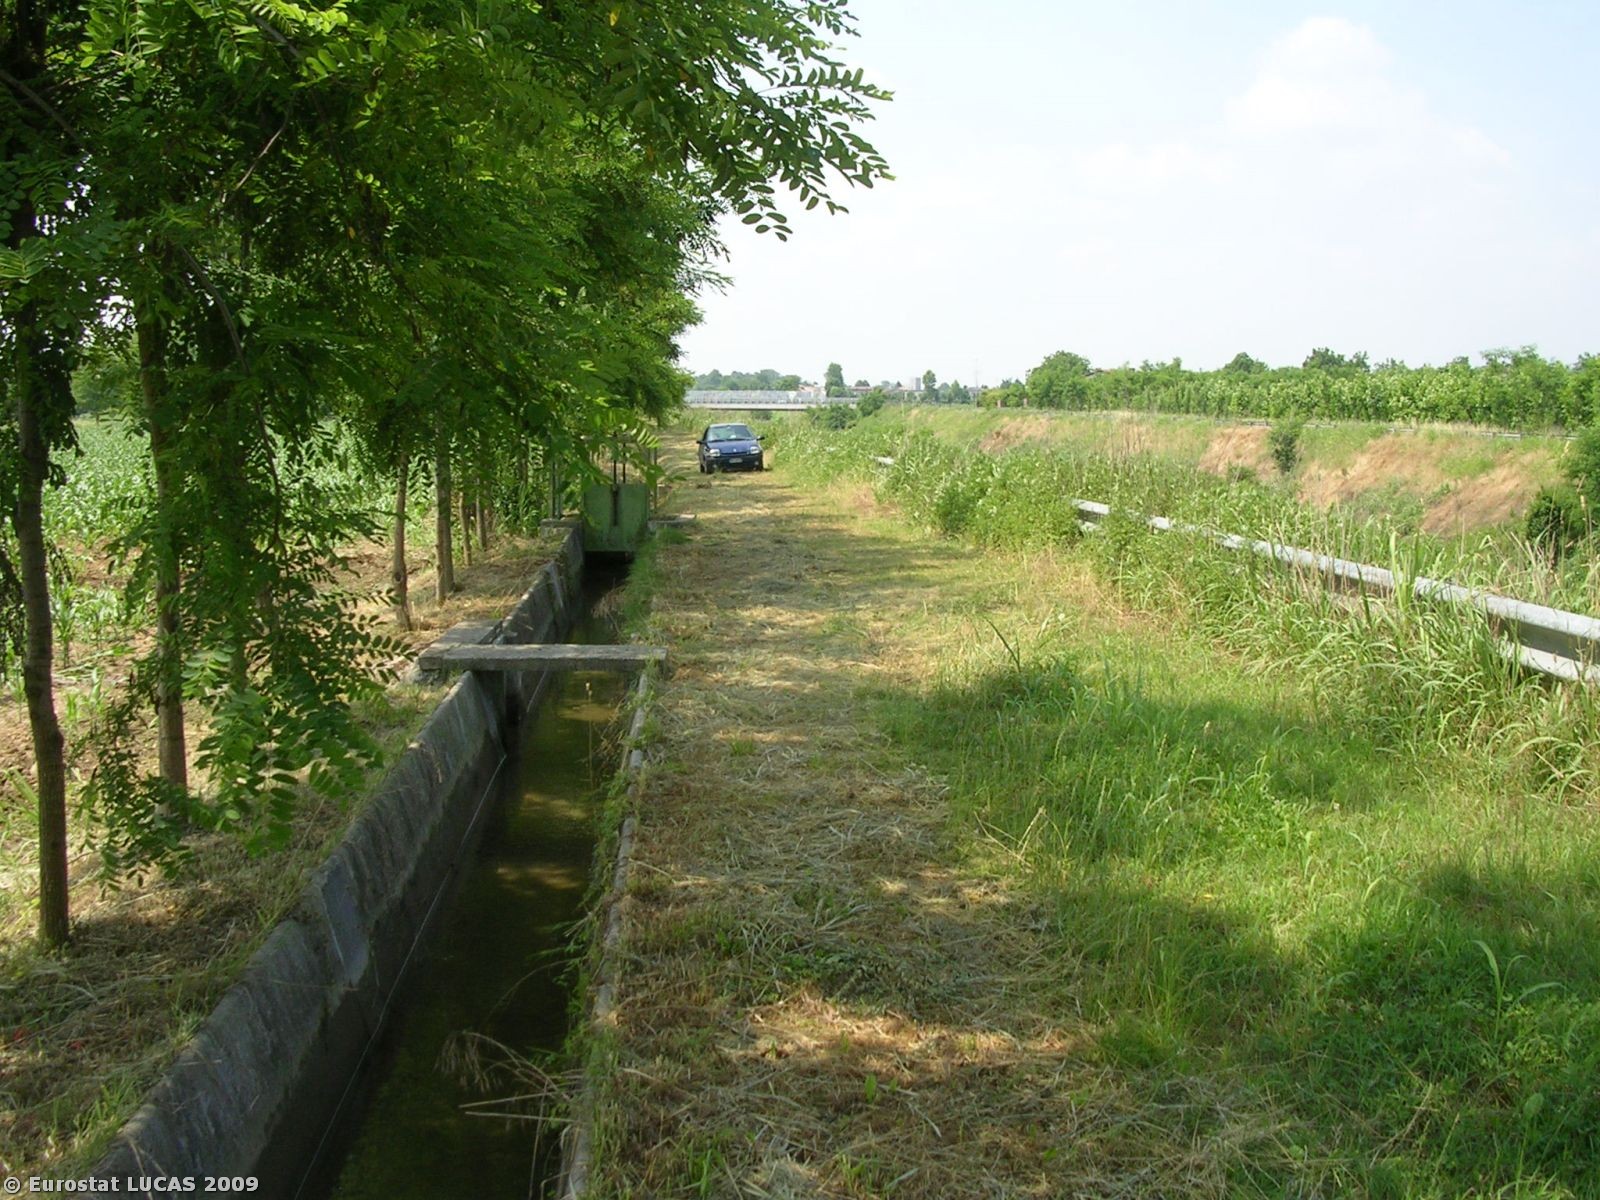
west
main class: Cropland
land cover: Maize
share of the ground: 50 - 75 %
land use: Agriculture (excluding fallow land and kitchen gardens)
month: June
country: IT
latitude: 45.6521
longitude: 11.7553
